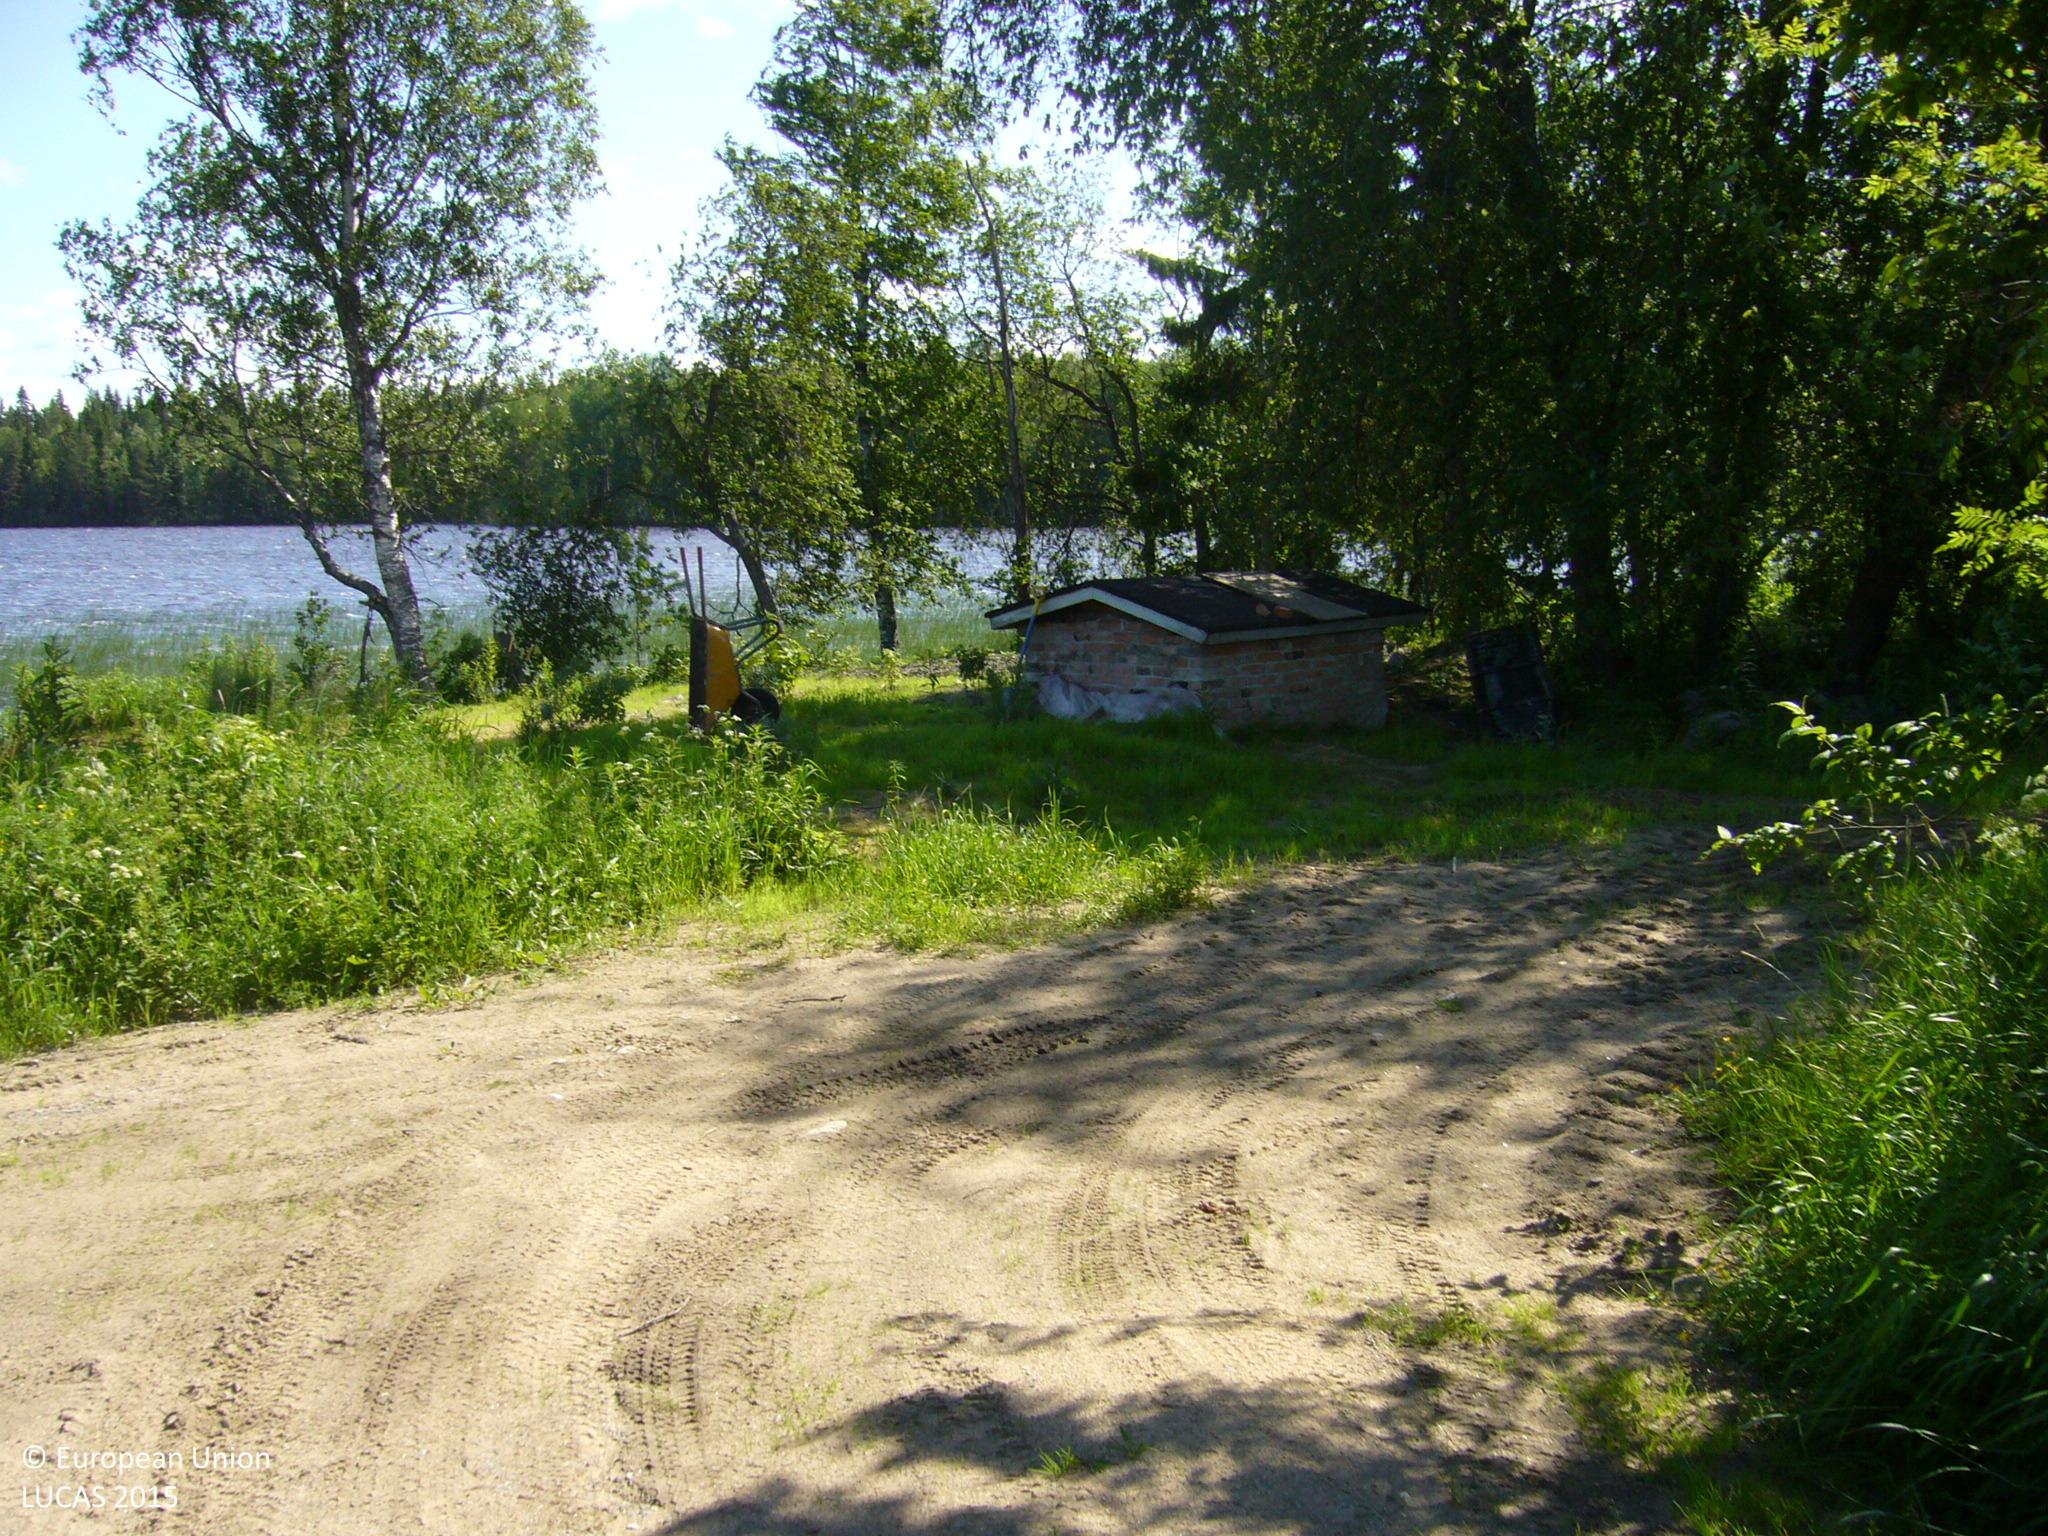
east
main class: Grassland
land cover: Grassland without tree/shrub cover
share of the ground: > 75 %
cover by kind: herbaceous plants 100 %
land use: Agriculture (excluding fallow land and kitchen gardens)
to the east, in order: Grassland without tree/shrub cover; Fences; Grassland without tree/shrub cover; Inland fresh water bodies
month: July
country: FI
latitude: 63.3310
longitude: 26.2373
